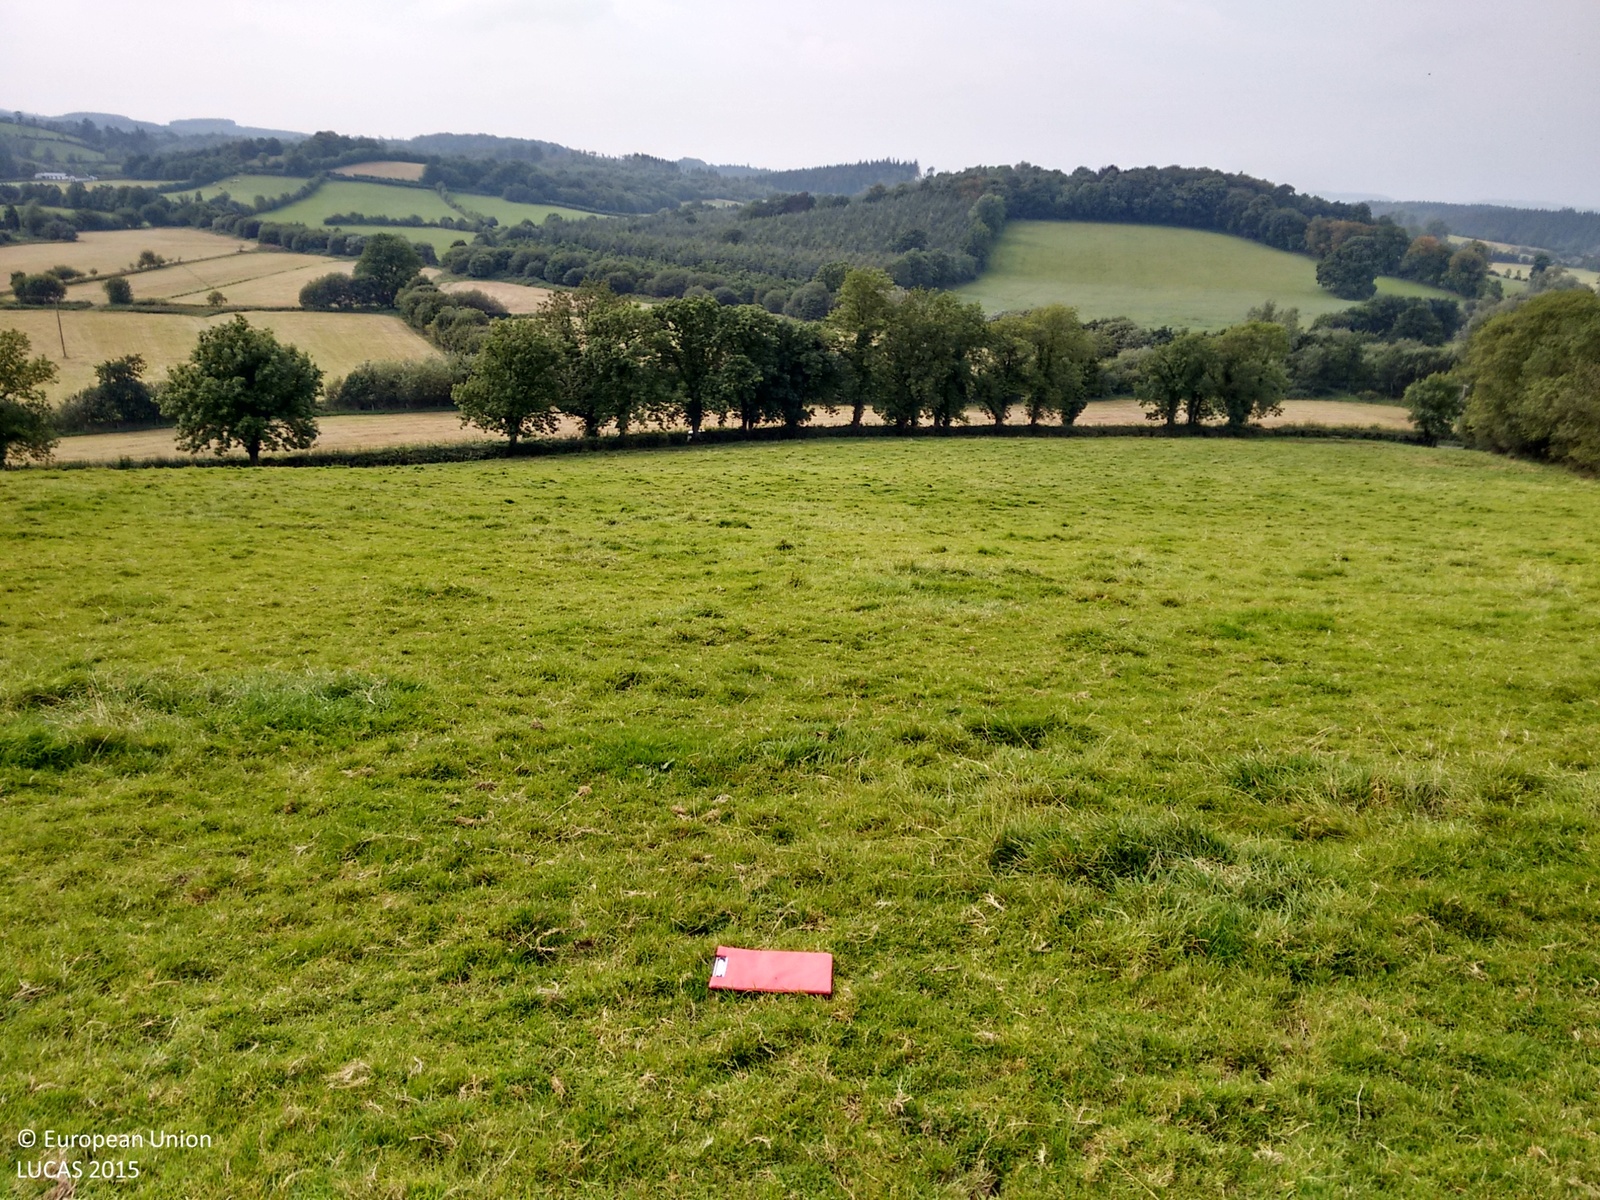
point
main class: Grassland
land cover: Grassland without tree/shrub cover
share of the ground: > 75 %
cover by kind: herbaceous plants 100 %
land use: Agriculture (excluding fallow land and kitchen gardens)
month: September
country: IE
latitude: 54.4124
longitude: -7.0124
